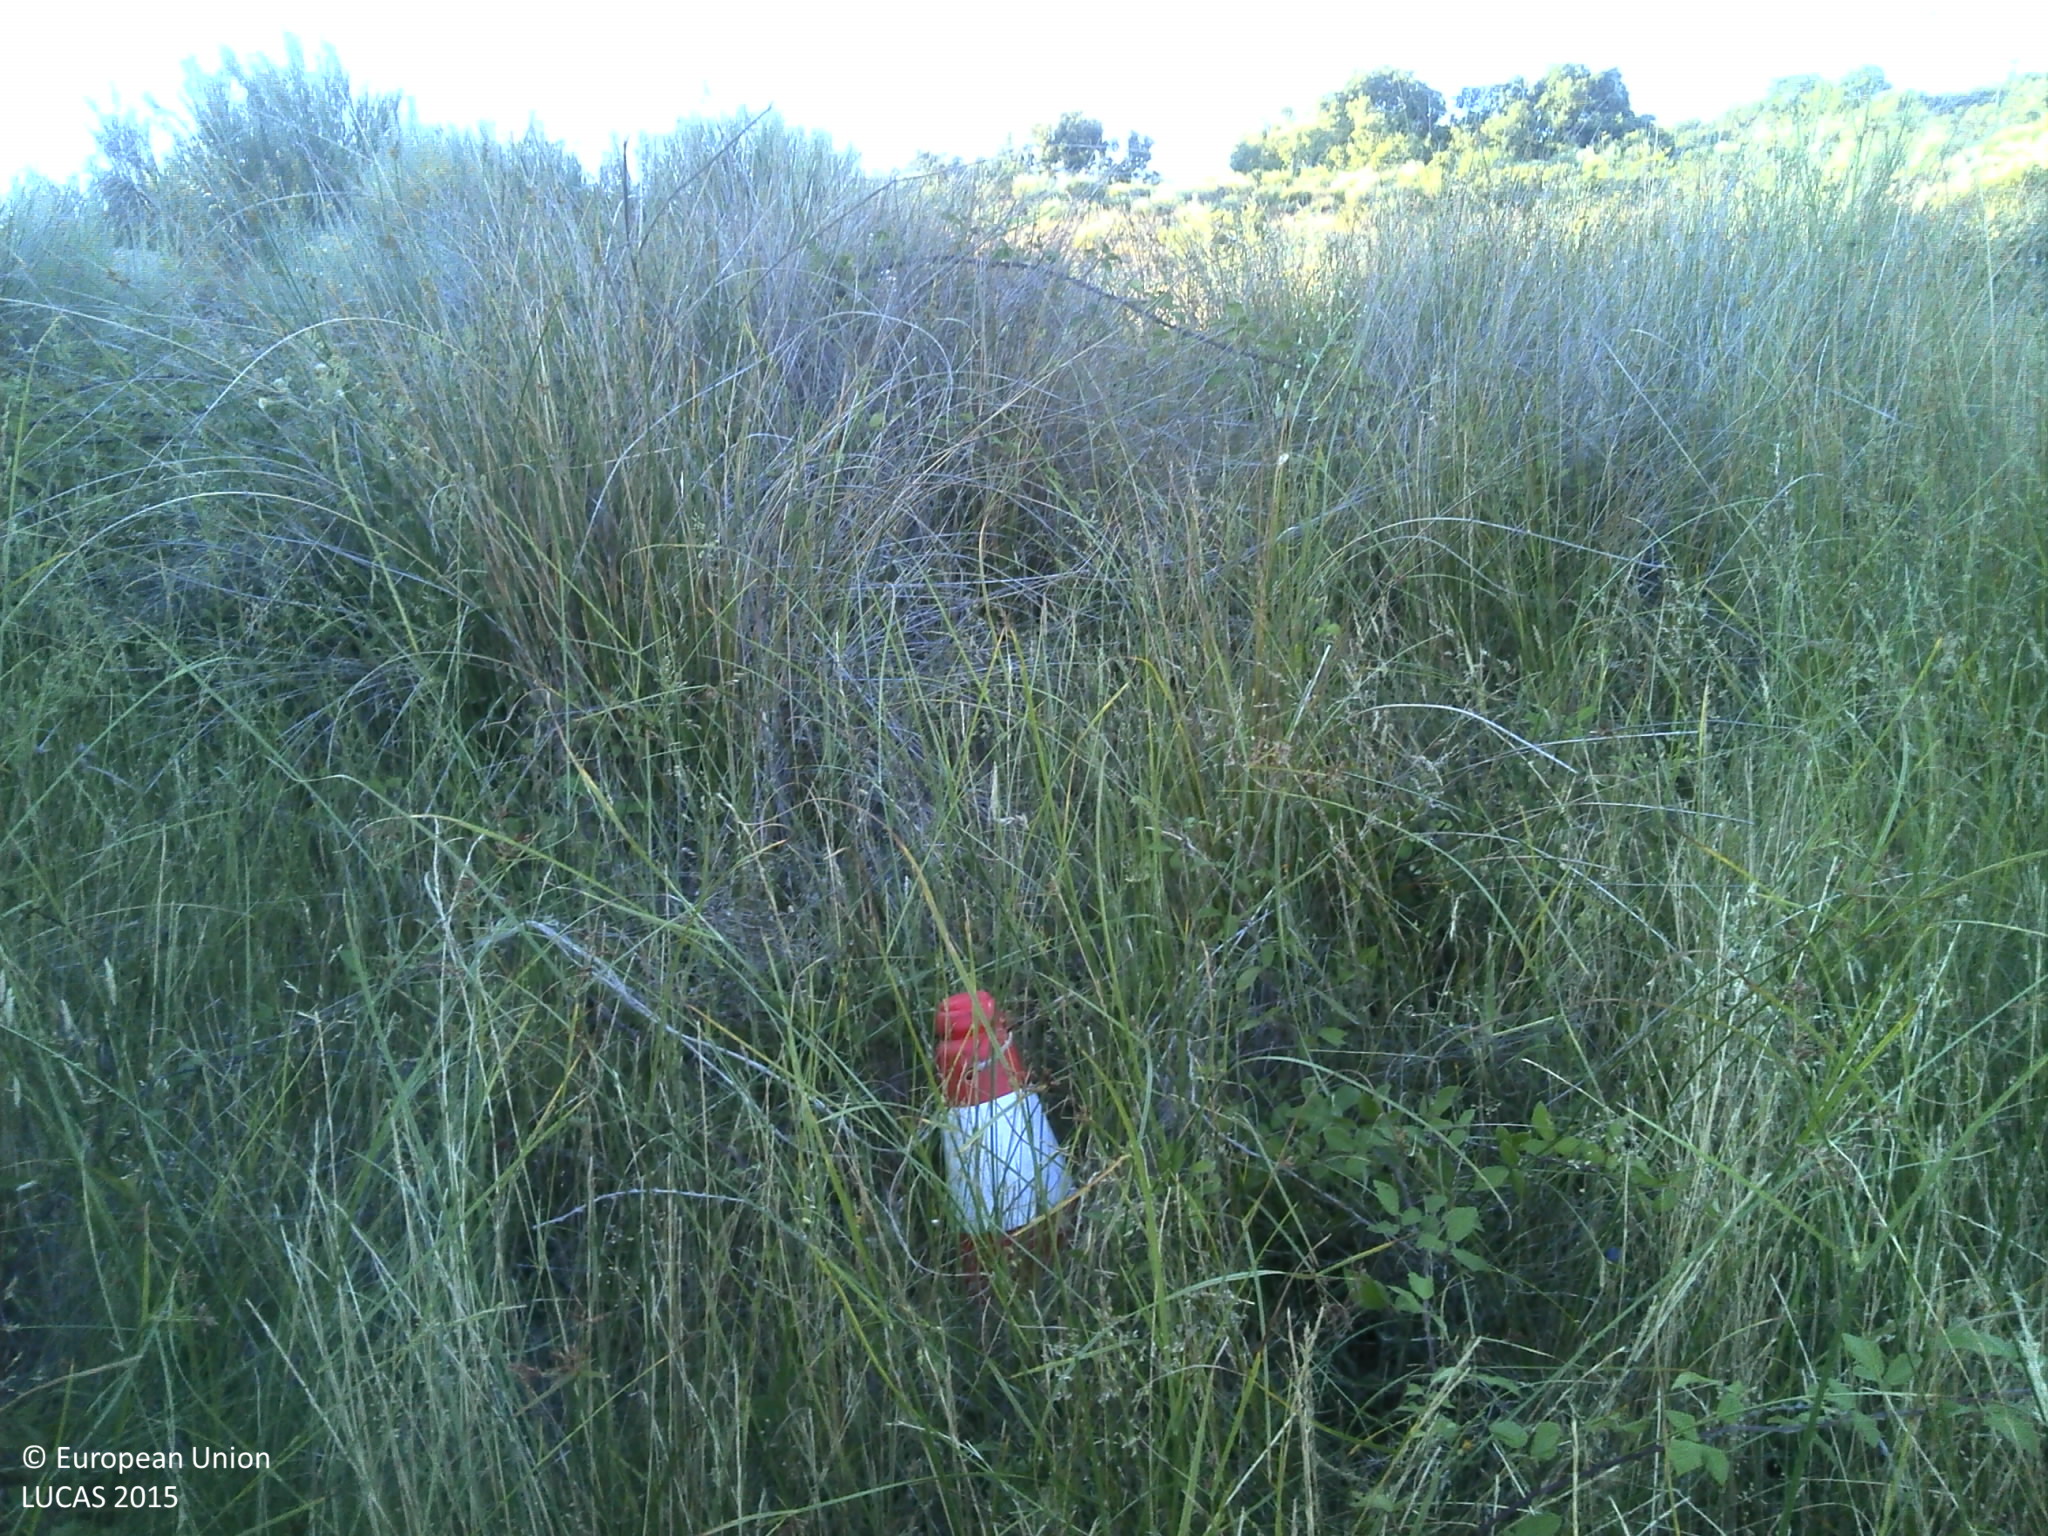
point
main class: Grassland
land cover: Grassland without tree/shrub cover
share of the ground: 50 - 75 %
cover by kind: herbaceous plants 70 %, unconsolidated bare surface 20 %, shrubs 5 %
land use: Agriculture (excluding fallow land and kitchen gardens)
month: June
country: PT
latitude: 39.9819
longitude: -7.3474
